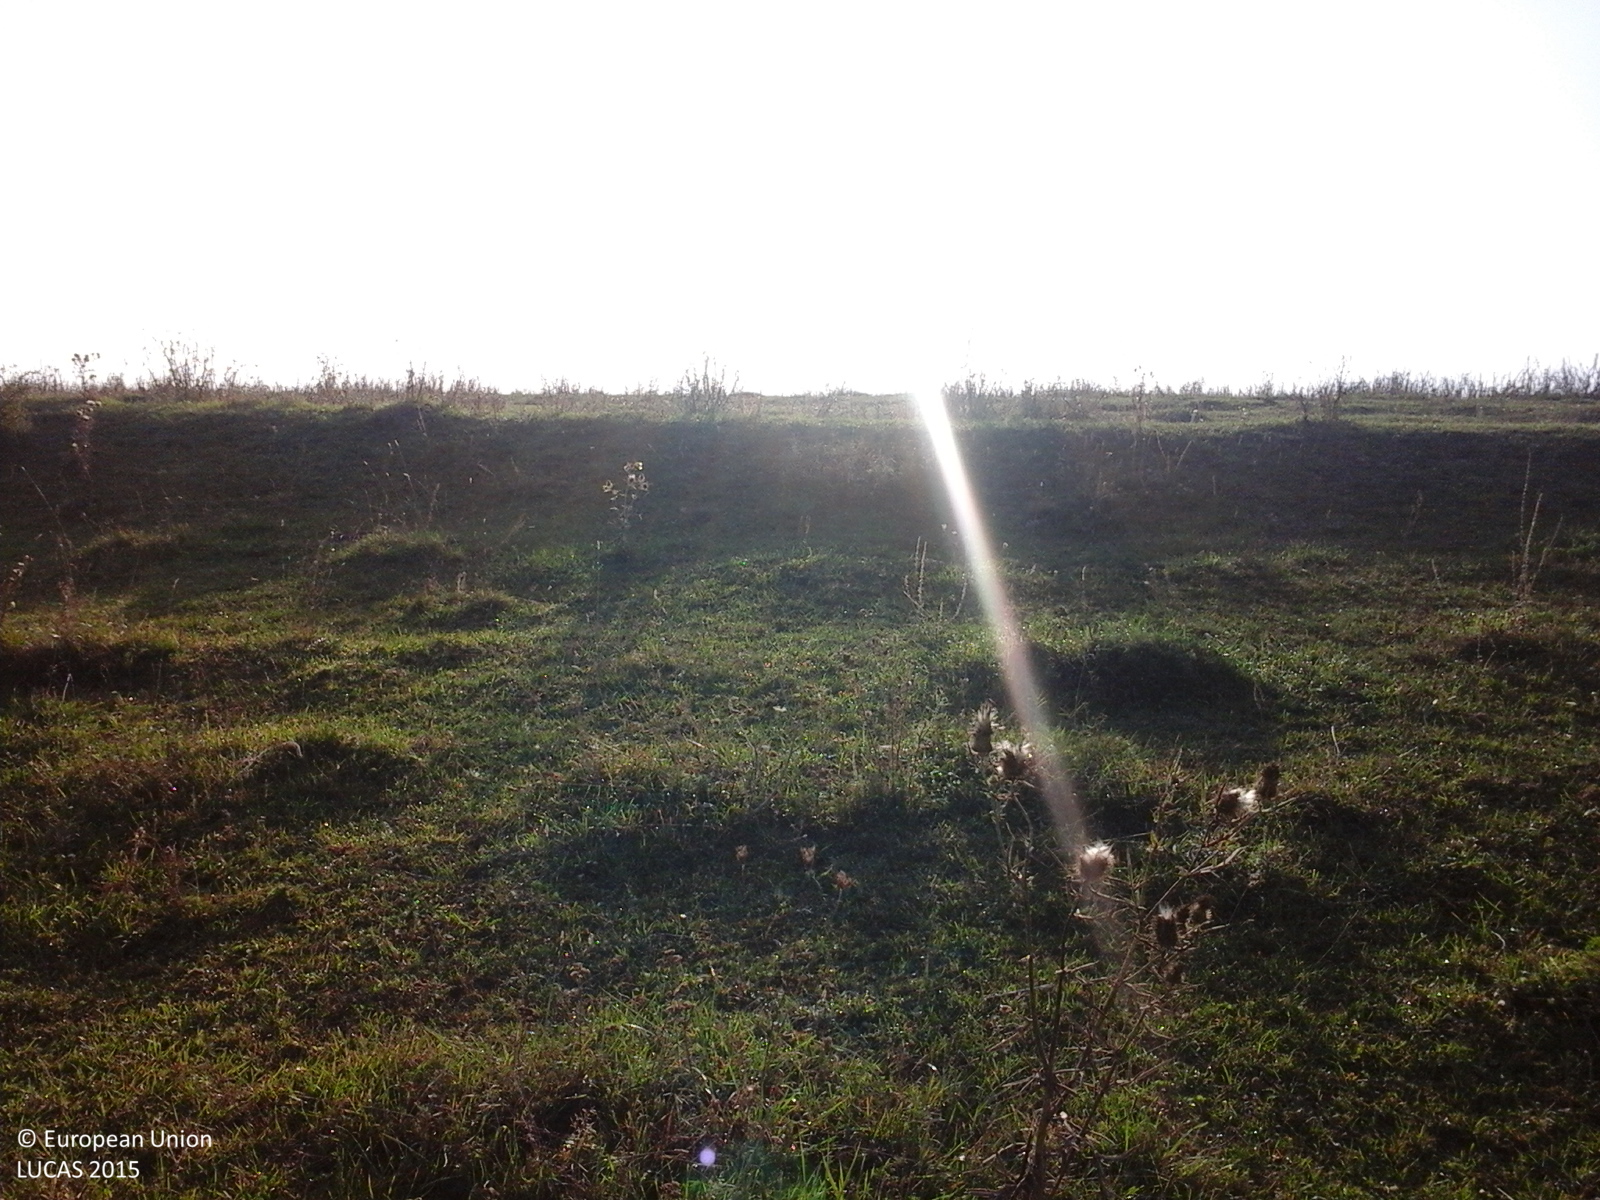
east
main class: Grassland
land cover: Grassland without tree/shrub cover
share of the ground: > 75 %
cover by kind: herbaceous plants 100 %
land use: Agriculture (excluding fallow land and kitchen gardens)
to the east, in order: Grassland without tree/shrub cover; Spontaneously vegetated surfaces; Grassland without tree/shrub cover
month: September
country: RO
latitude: 46.8384
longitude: 23.3761
